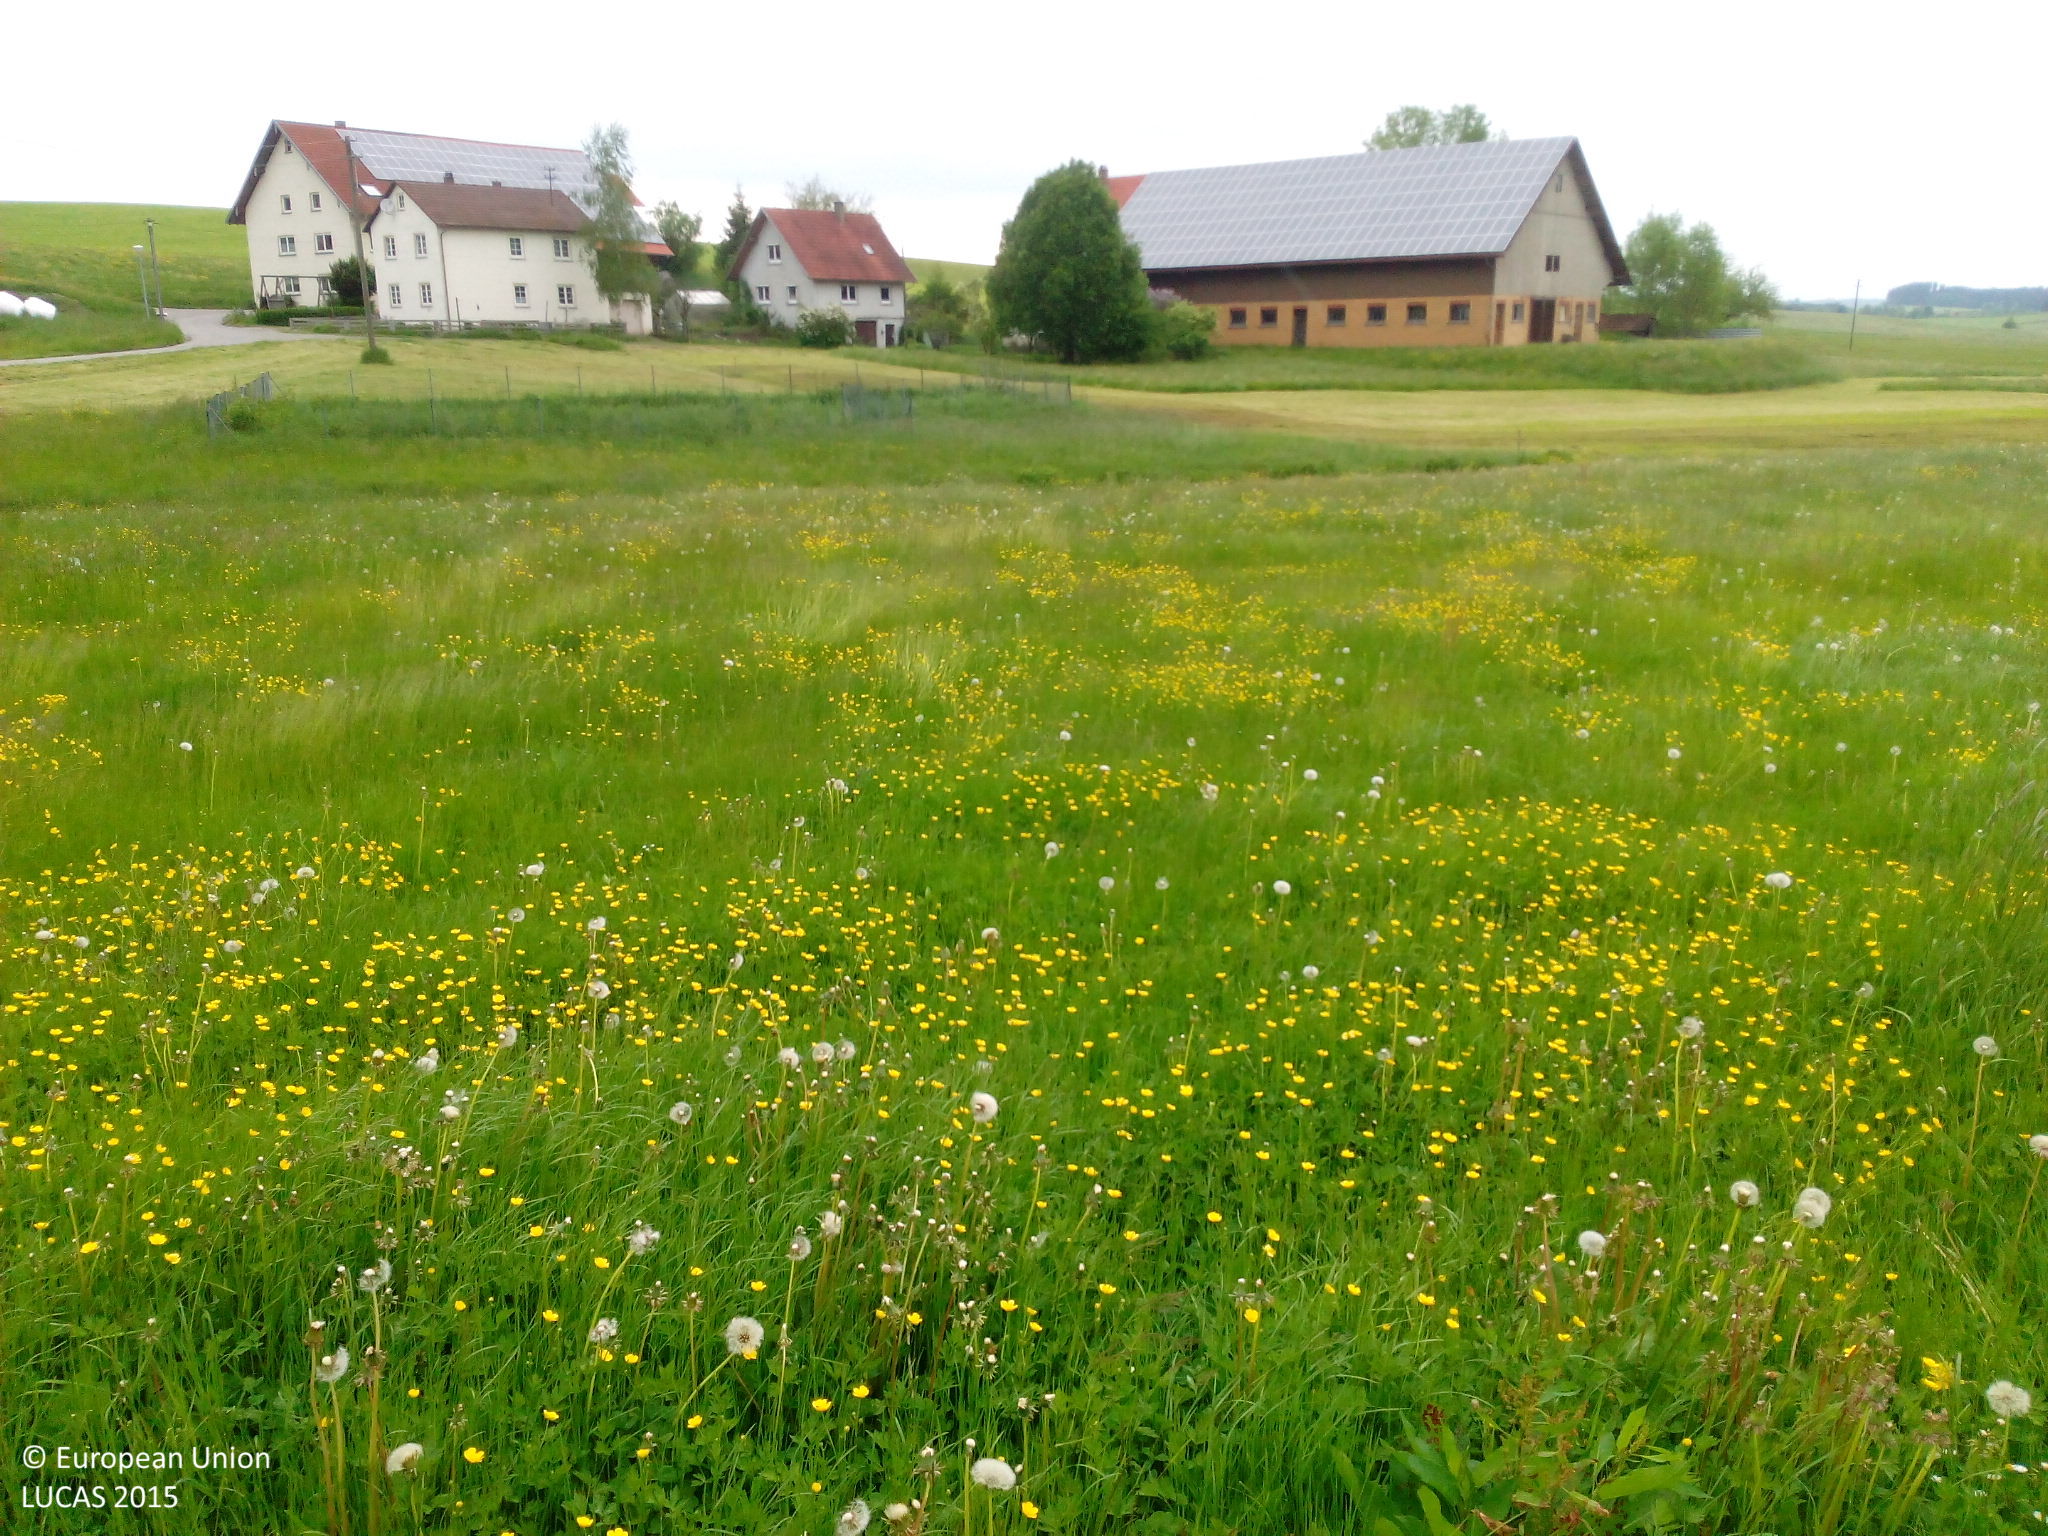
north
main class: Grassland
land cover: Grassland without tree/shrub cover
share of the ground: > 75 %
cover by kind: herbaceous plants 100 %
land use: Agriculture (excluding fallow land and kitchen gardens)
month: May
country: DE
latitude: 47.7916
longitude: 9.9333
